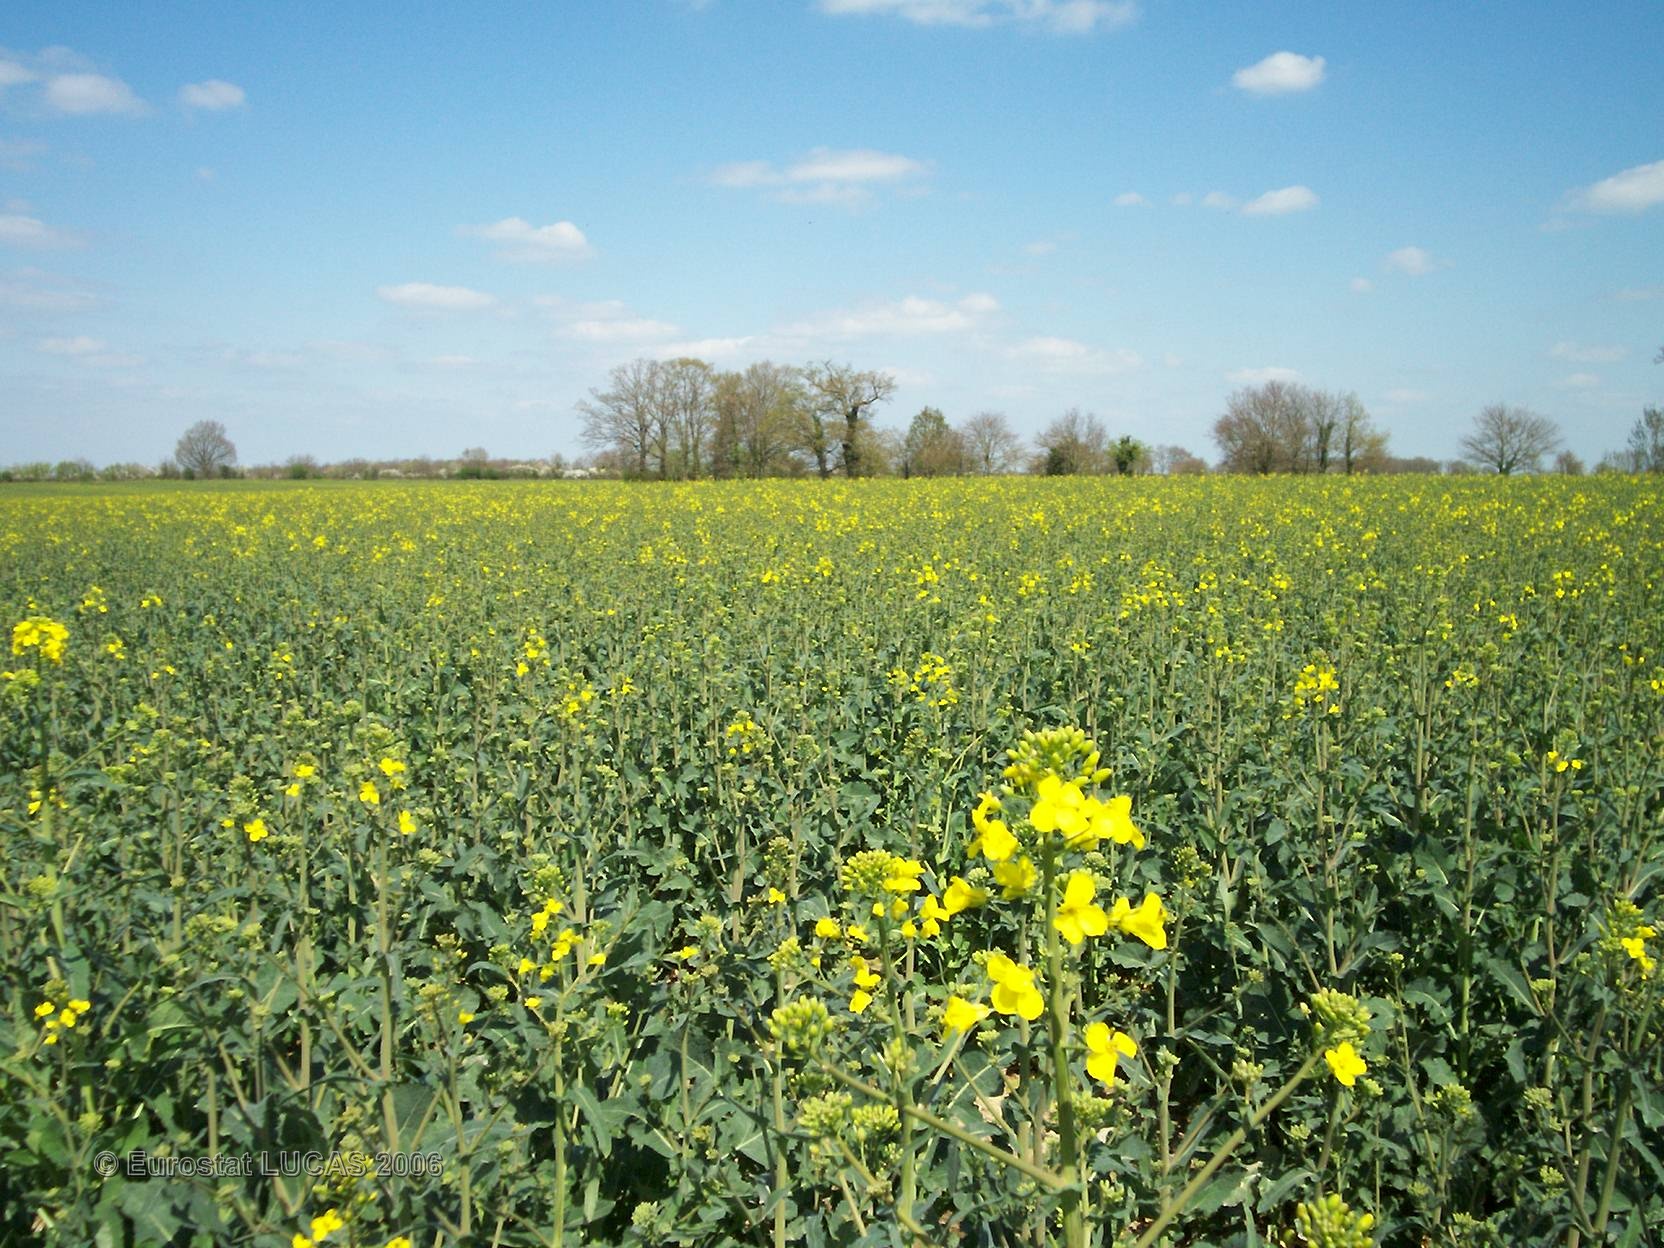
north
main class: Cropland
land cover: Rape and turnip rape
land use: Agriculture (excluding fallow land and kitchen gardens)
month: April
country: FR
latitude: 46.7066
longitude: 1.5791
